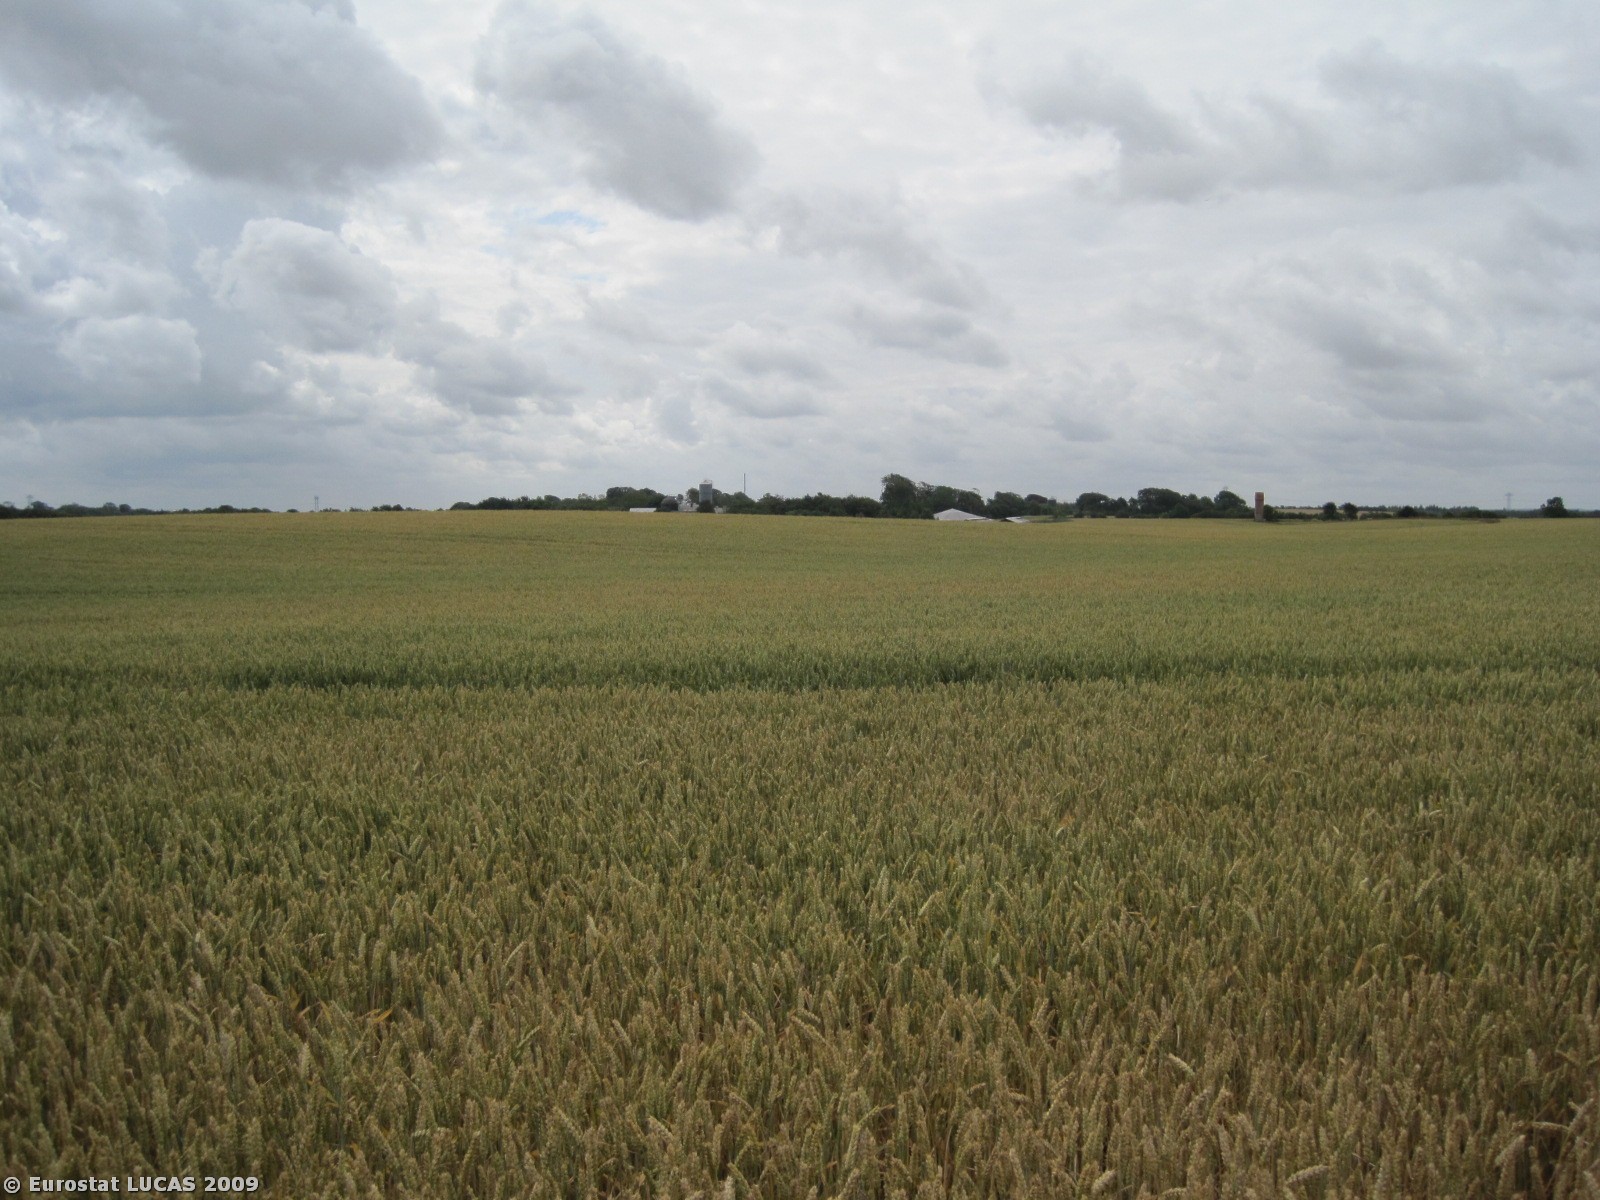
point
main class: Cropland
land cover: Common wheat
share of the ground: > 75 %
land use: Agriculture (excluding fallow land and kitchen gardens)
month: July
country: DK
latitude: 56.4157
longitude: 8.7858
